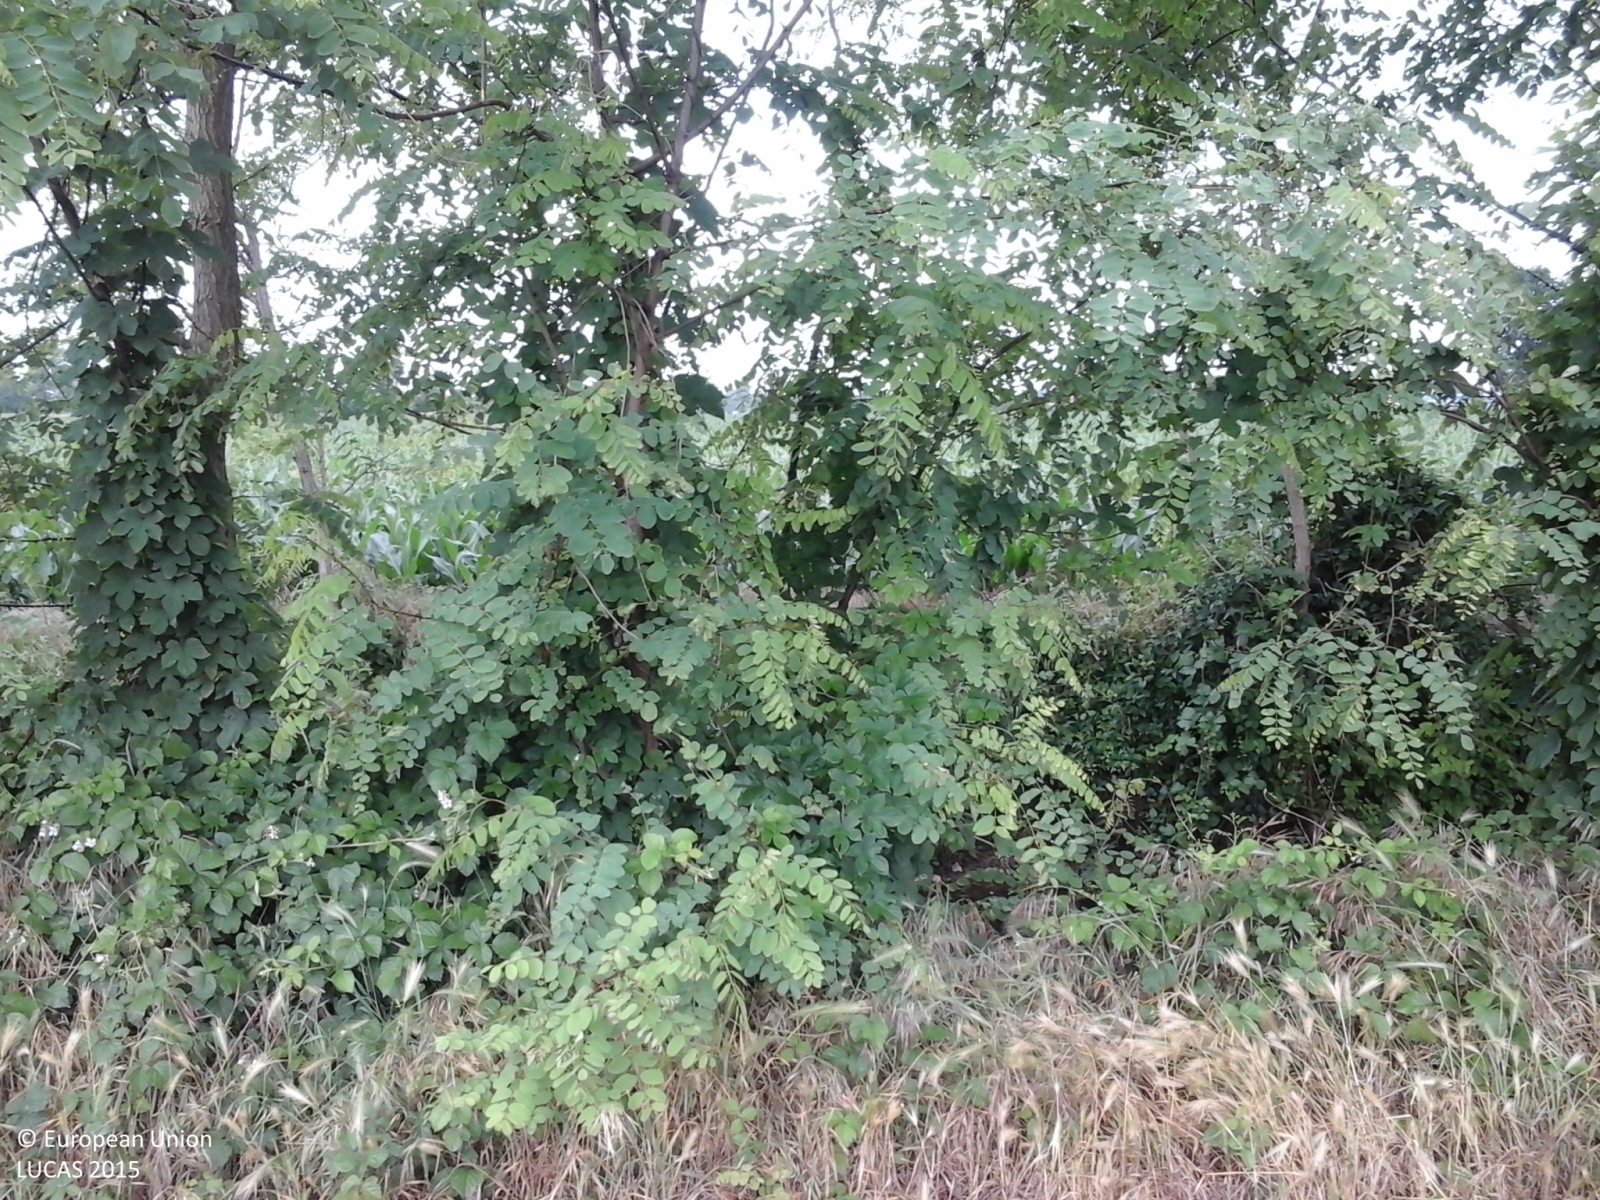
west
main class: Cropland
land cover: Maize
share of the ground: > 75 %
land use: Agriculture (excluding fallow land and kitchen gardens)
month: May
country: IT
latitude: 45.3962
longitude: 9.9107
